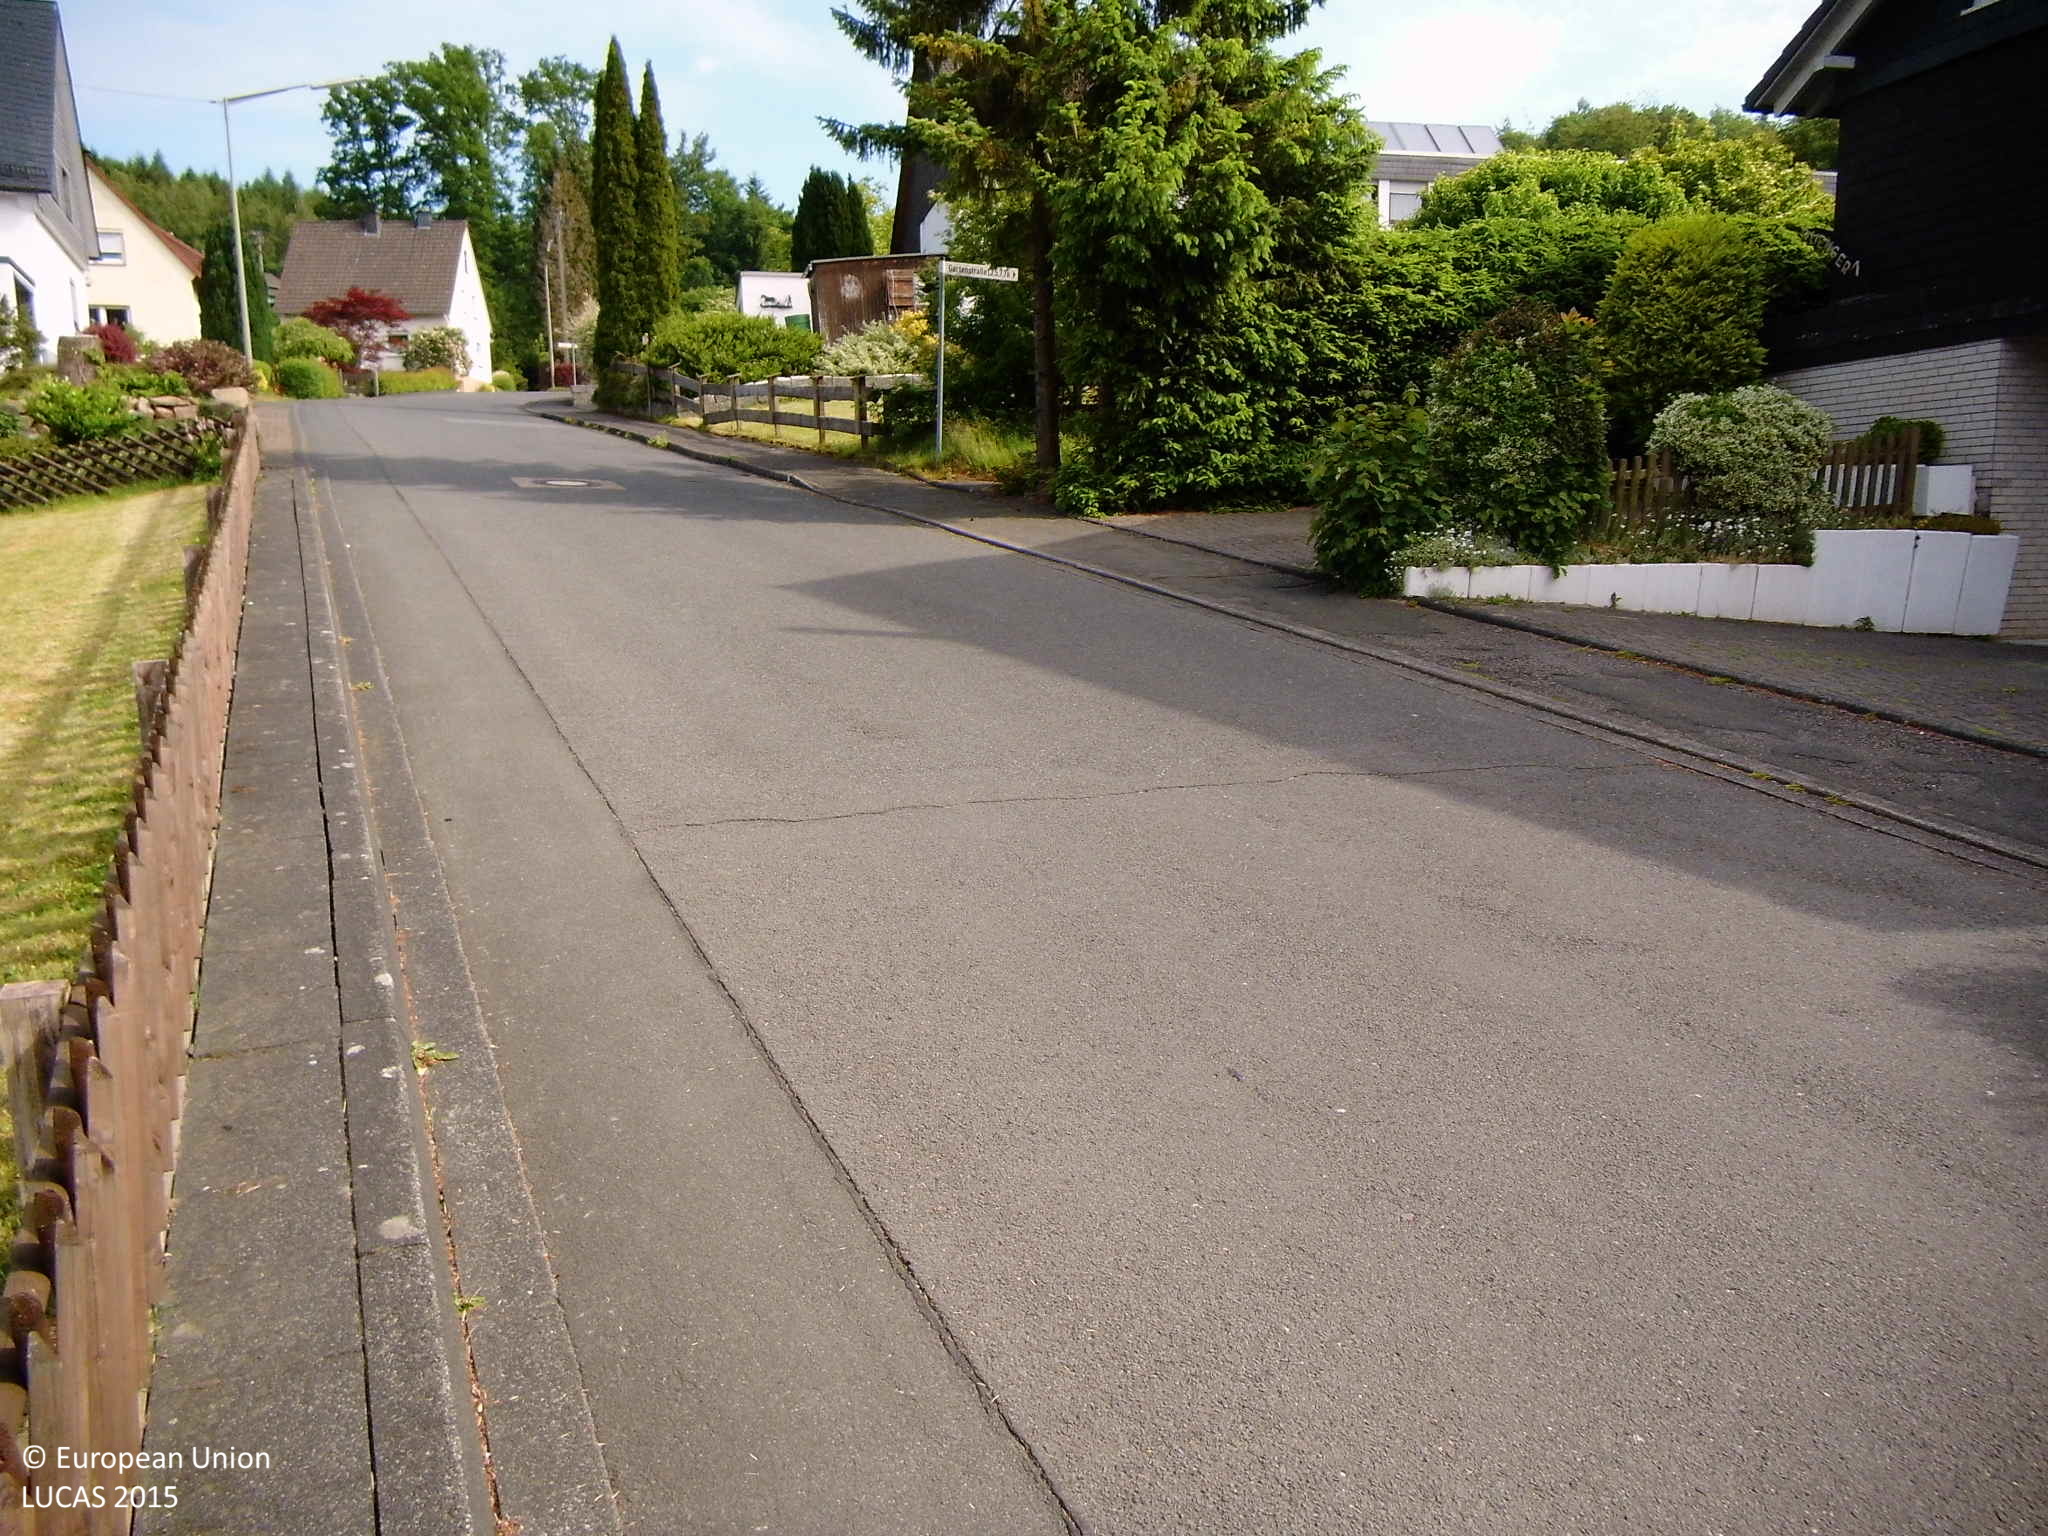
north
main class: Woodland
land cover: Broadleaved woodland
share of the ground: 25 - 50 %
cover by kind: herbaceous plants 55 %, broadleaved forest trees 40 %, shrubs 5 %
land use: Residential
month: June
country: DE
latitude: 50.9774
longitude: 8.0776
